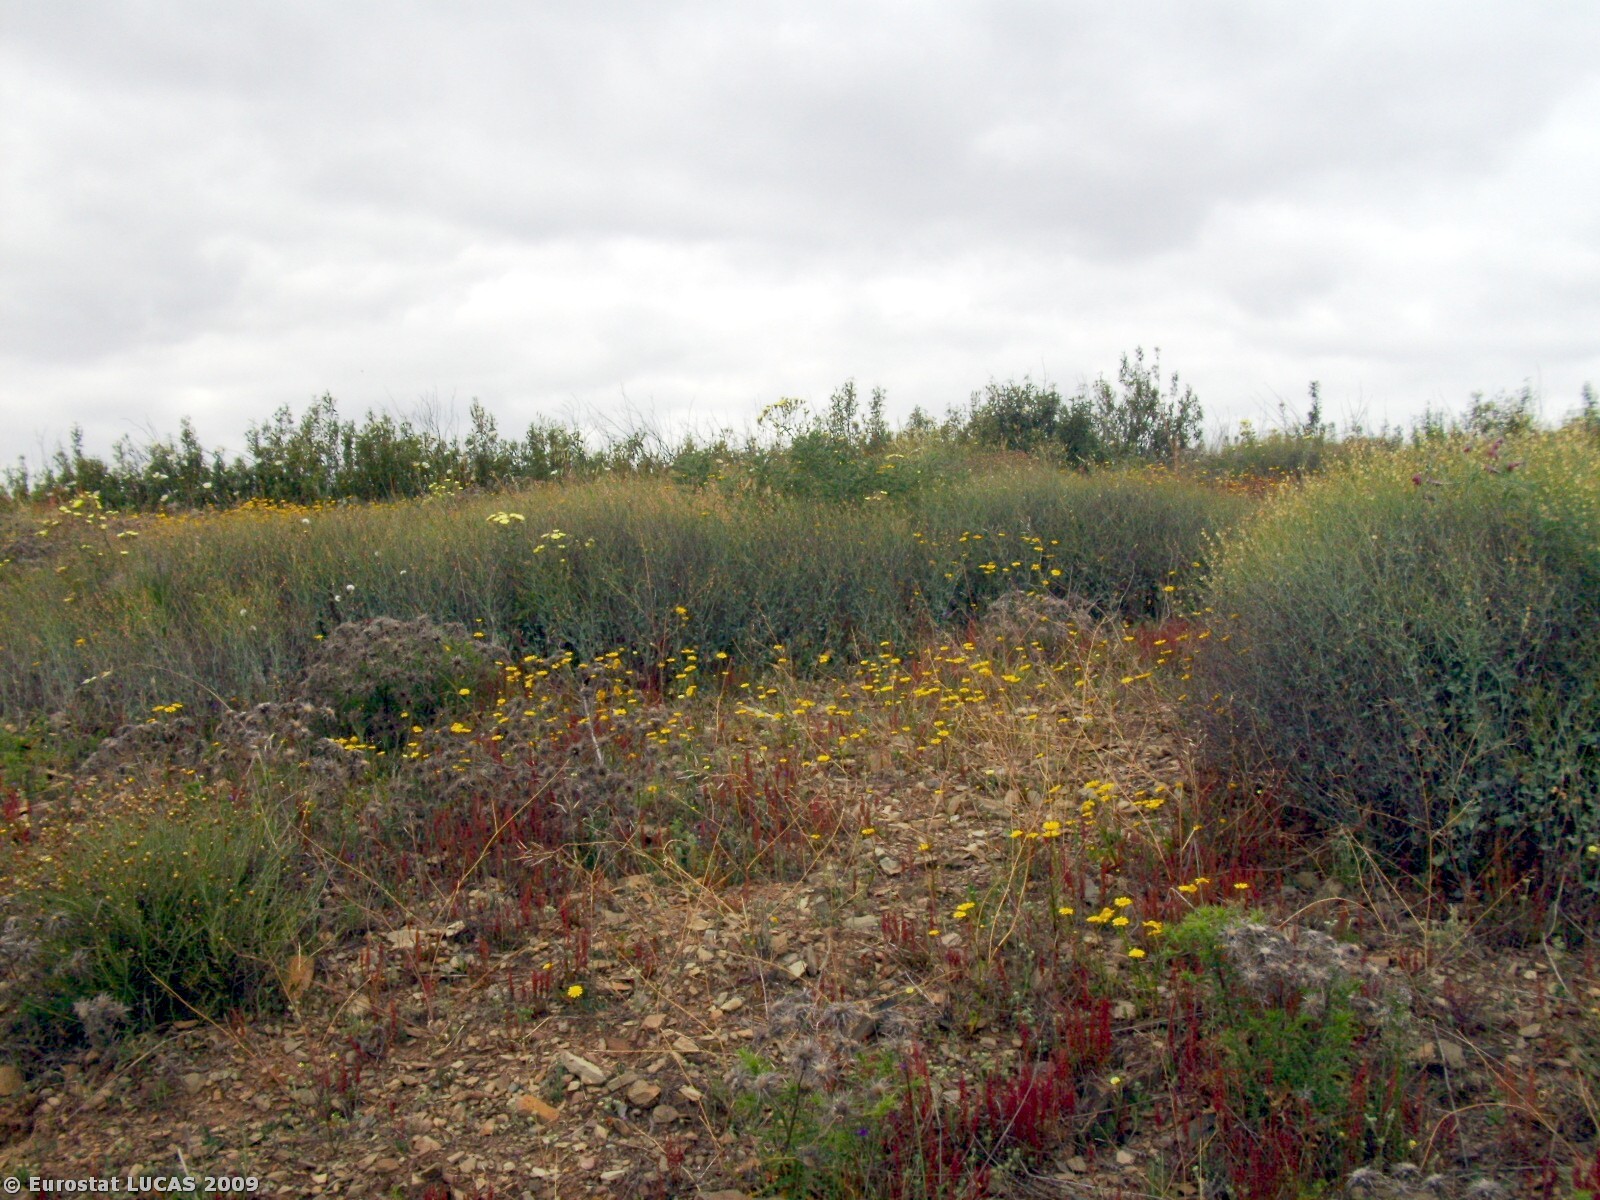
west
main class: Shrubland
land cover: Shrubland without tree cover
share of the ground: > 75 %
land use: Unused
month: April
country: PT
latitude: 37.2345
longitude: -7.6242
